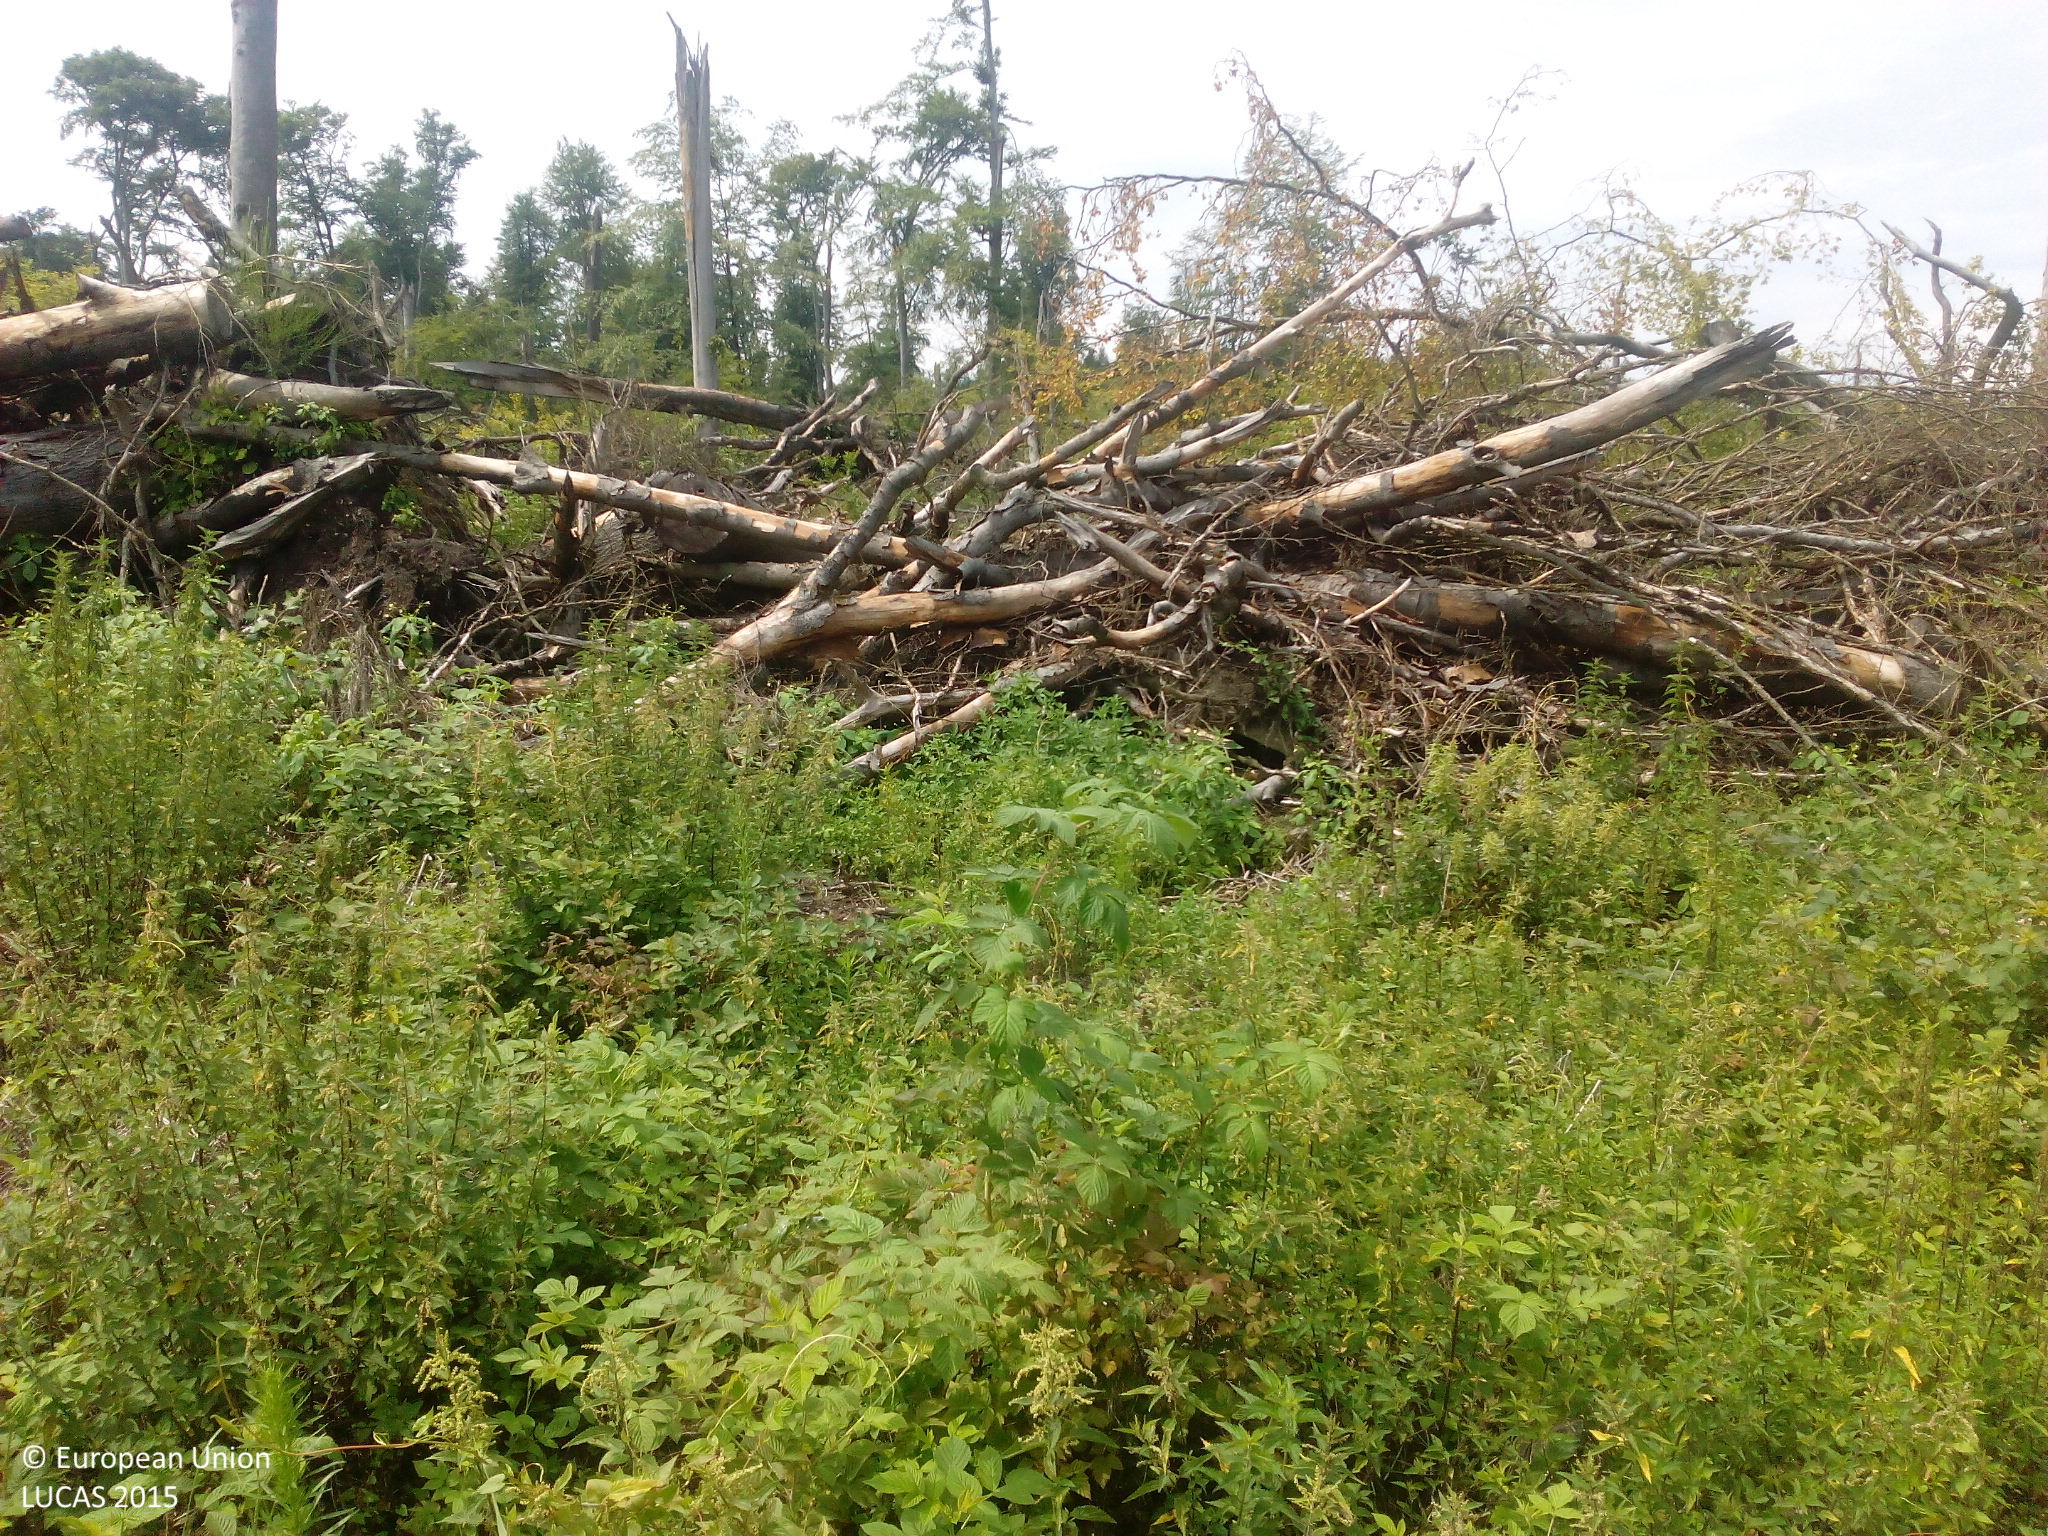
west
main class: Grassland
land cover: Spontaneously vegetated surfaces
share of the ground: > 75 %
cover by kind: herbaceous plants 75 %
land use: Semi-natural and natural areas not in use
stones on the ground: < 10 %
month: July
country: DE
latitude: 52.0301
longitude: 12.3755
